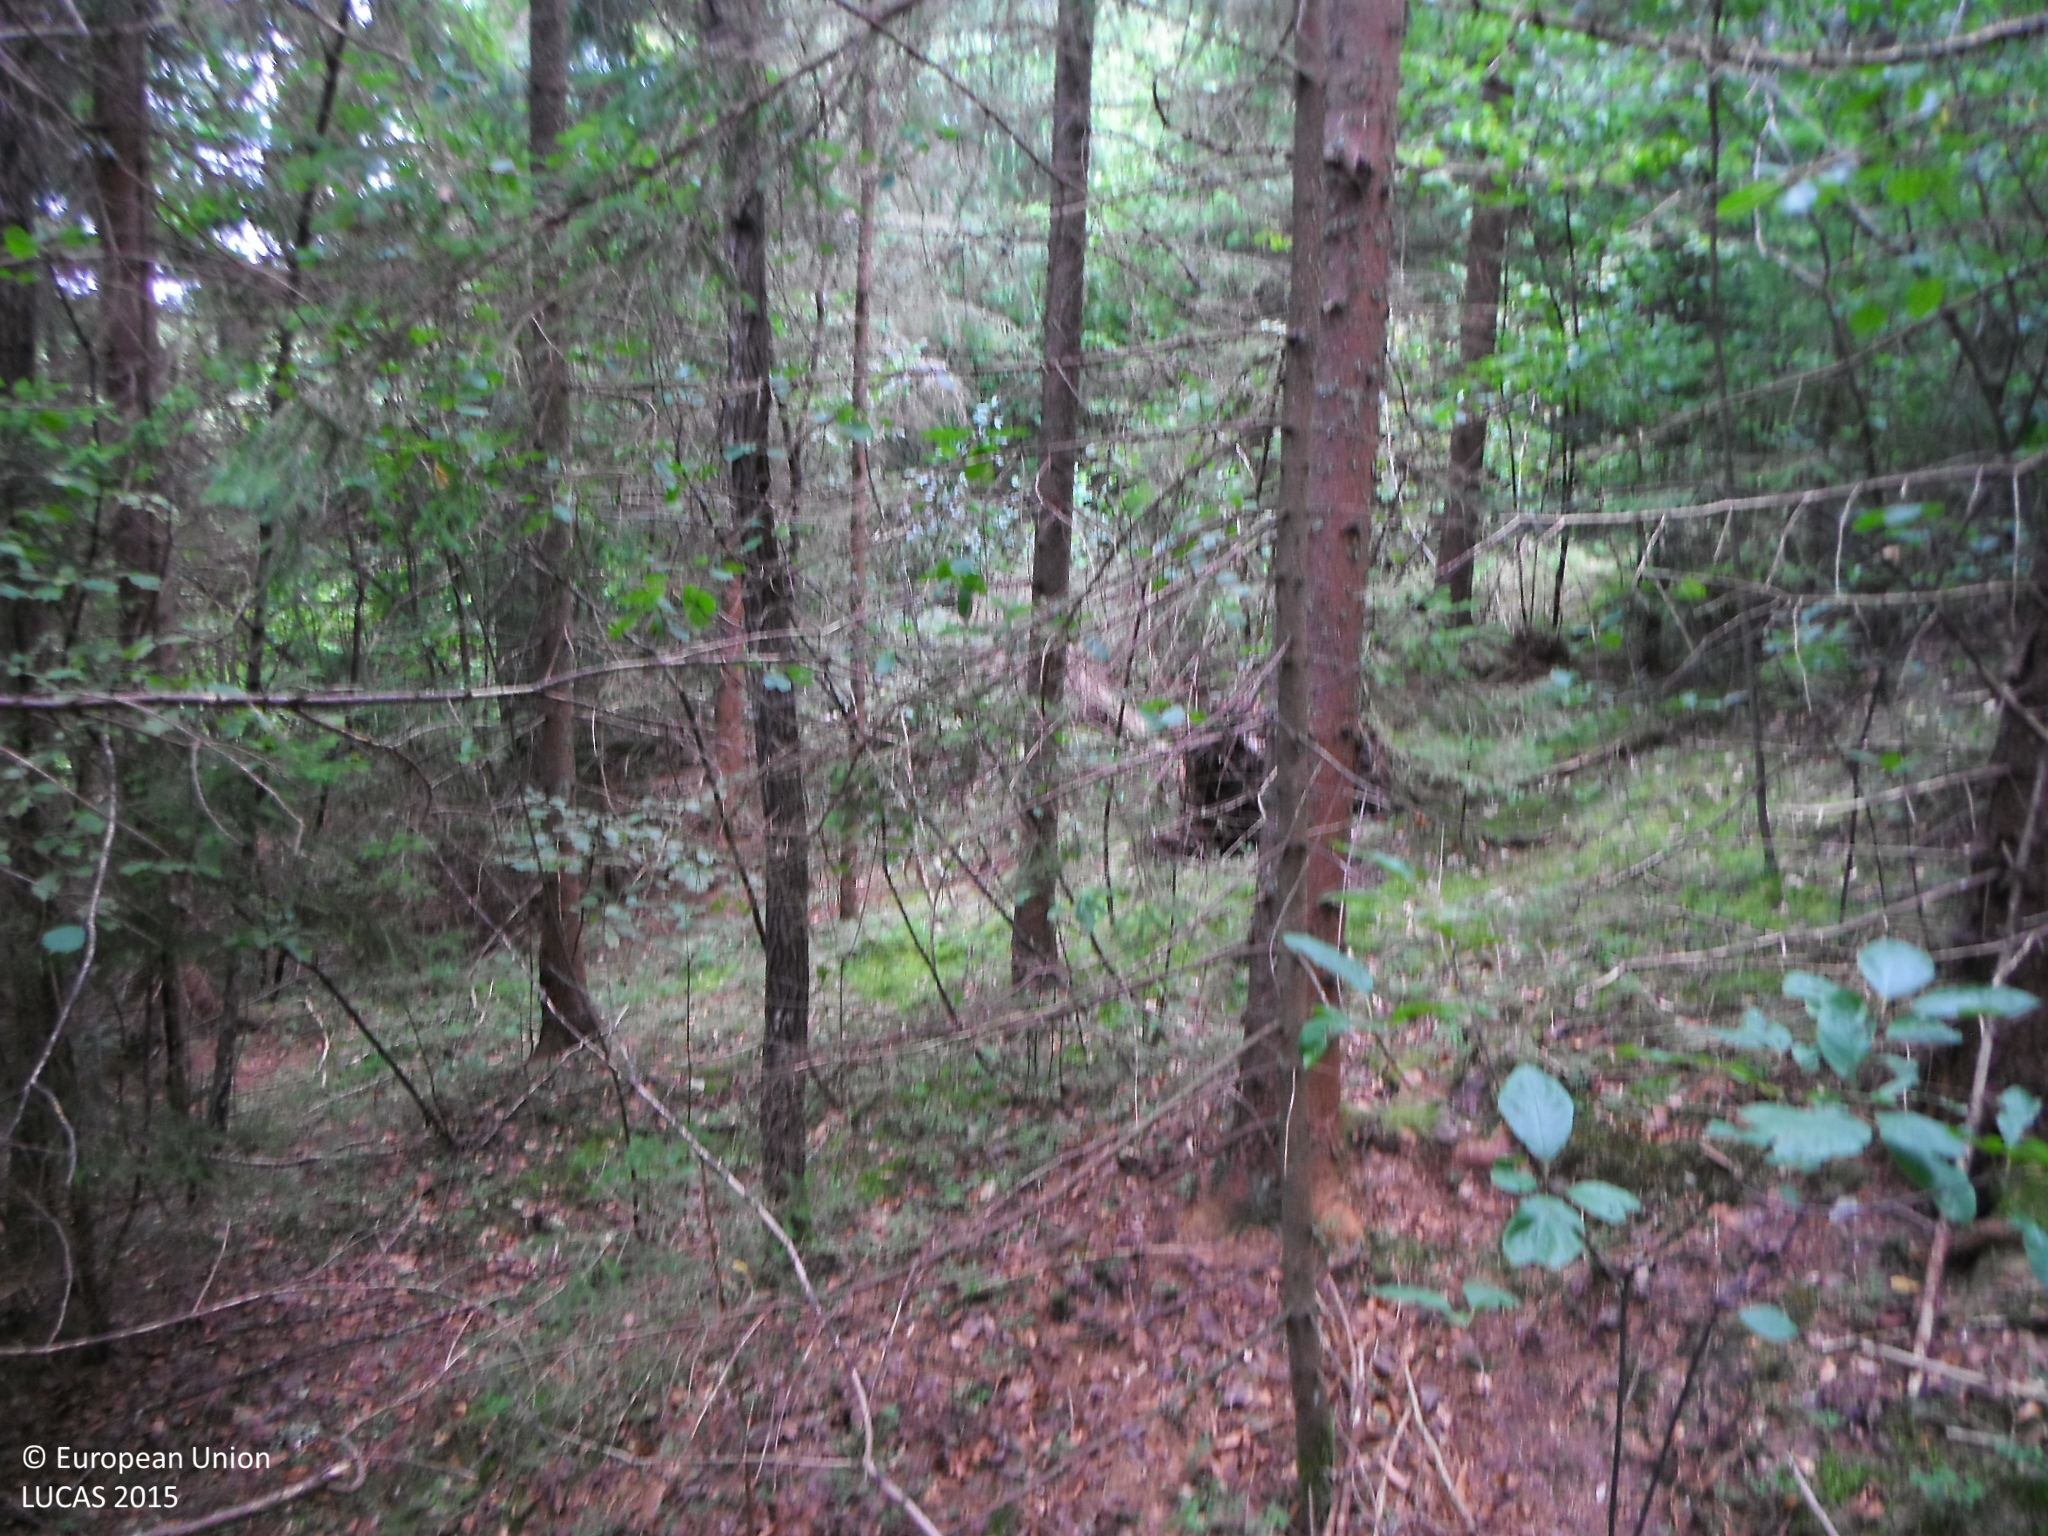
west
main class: Woodland
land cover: Spruce dominated coniferous woodland
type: alpine coniferous forest
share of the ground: > 75 %
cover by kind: coniferous forest trees 100 %
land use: Forestry
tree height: > 5 m
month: August
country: SK
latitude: 48.8511
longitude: 20.0476
